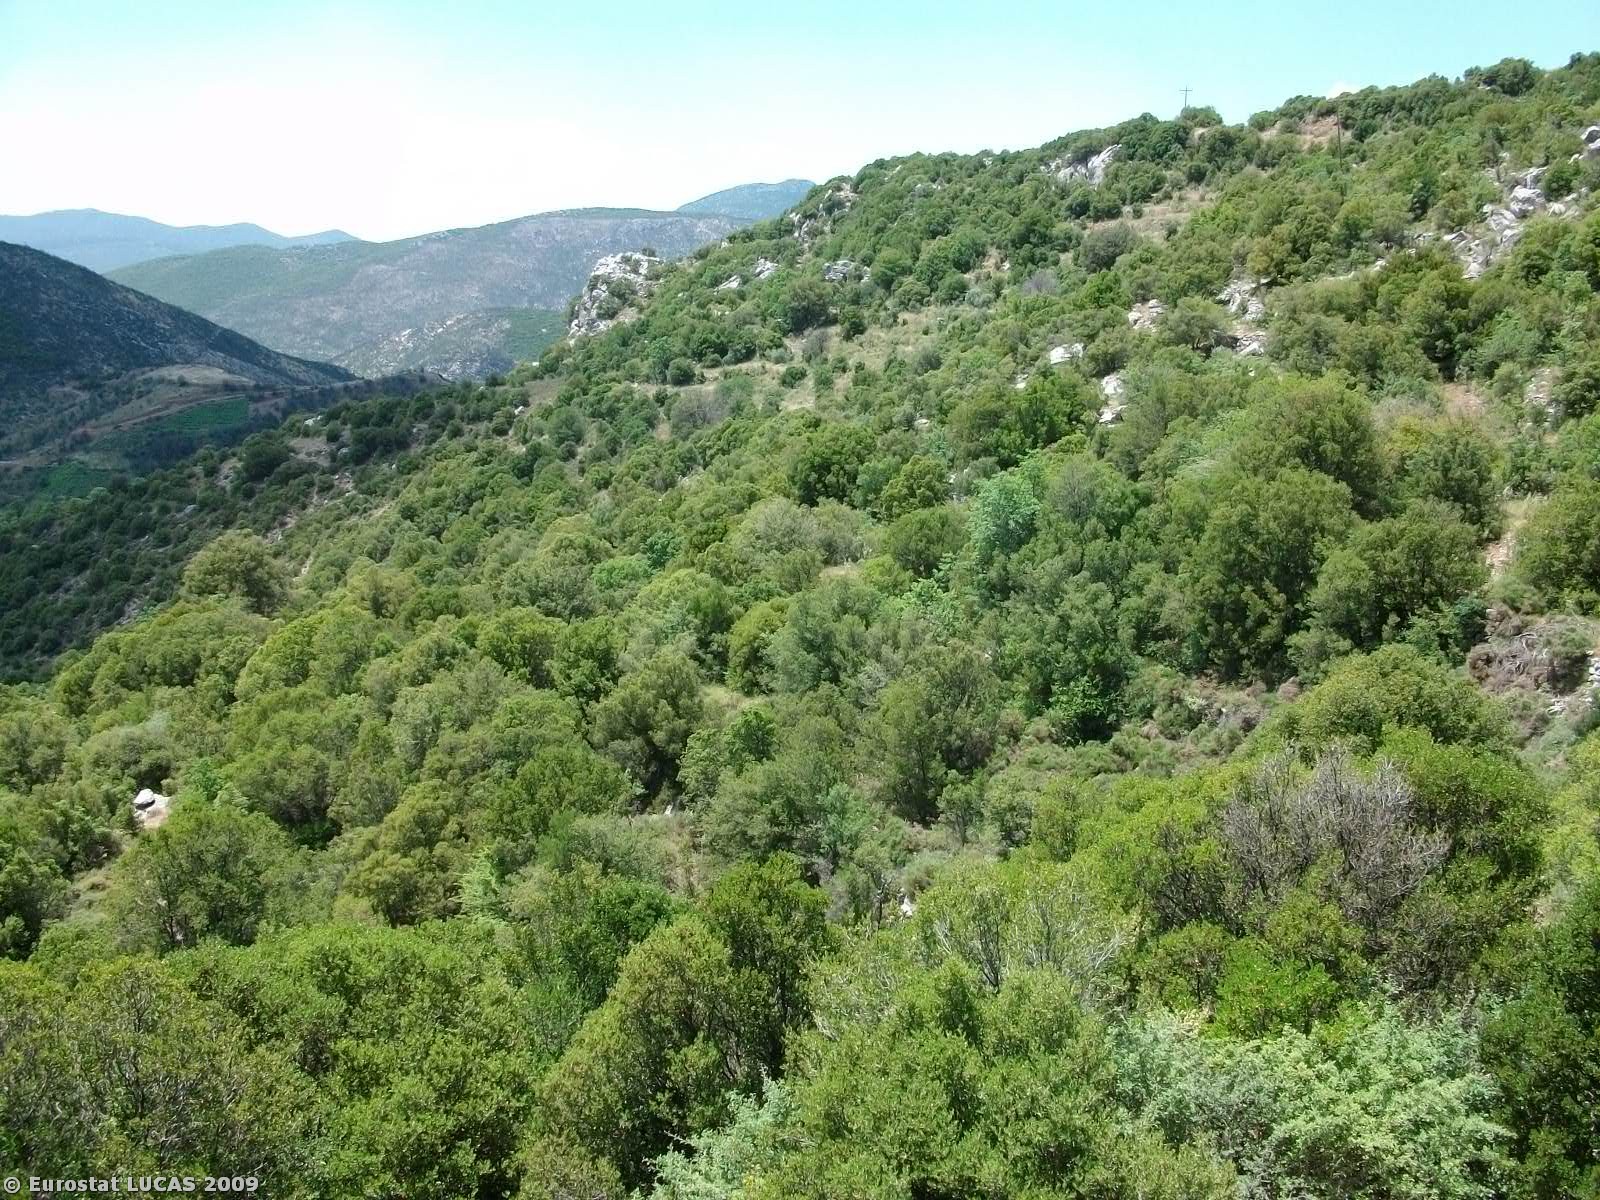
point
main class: Woodland
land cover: Broadleaved woodland
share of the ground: > 75 %
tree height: < 5 m
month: June
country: GR
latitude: 37.1817
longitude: 22.1773
